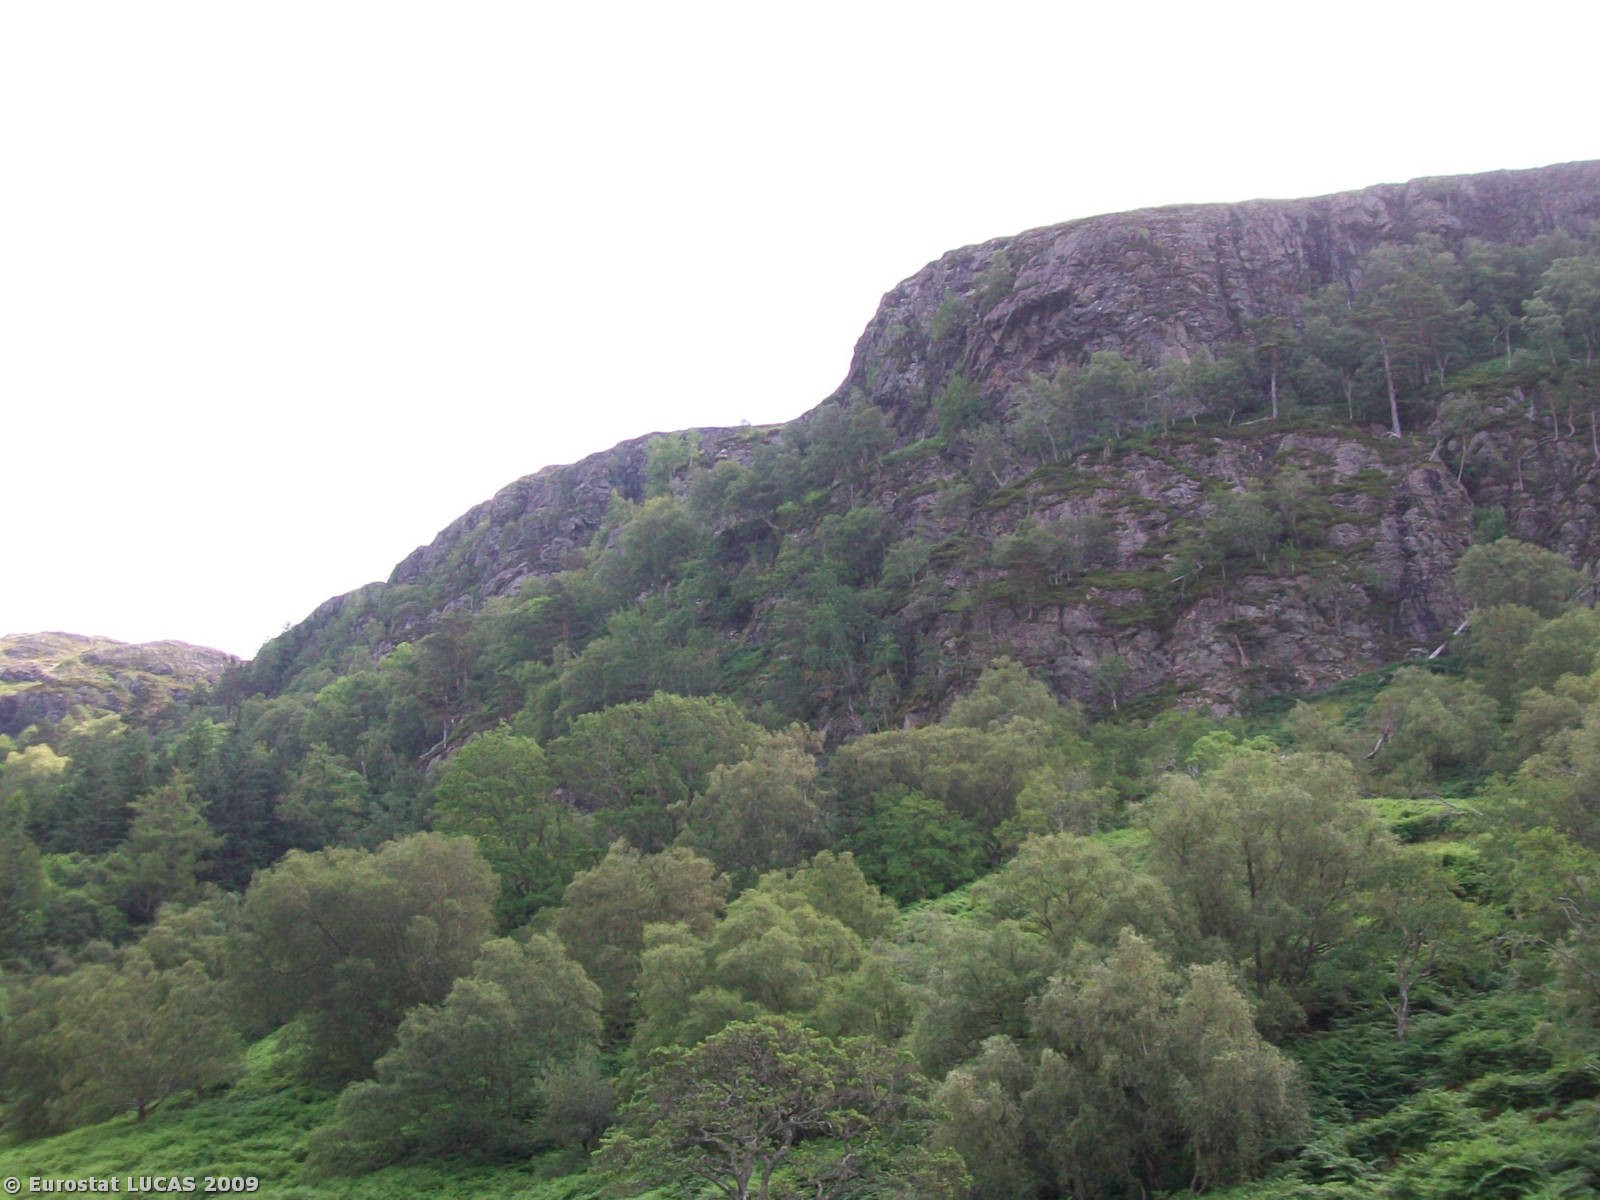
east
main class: Grassland
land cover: Grassland with sparse tree/shrub cover
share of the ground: > 75 %
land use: Forestry
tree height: > 5 m
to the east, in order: Grassland with sparse tree/shrub cover; Bare land; Grassland with sparse tree/shrub cover; Bare land; Shrubland without tree cover; Rock outcrops; Shrubland without tree cover
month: July
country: GB
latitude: 57.8275
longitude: -5.1753
